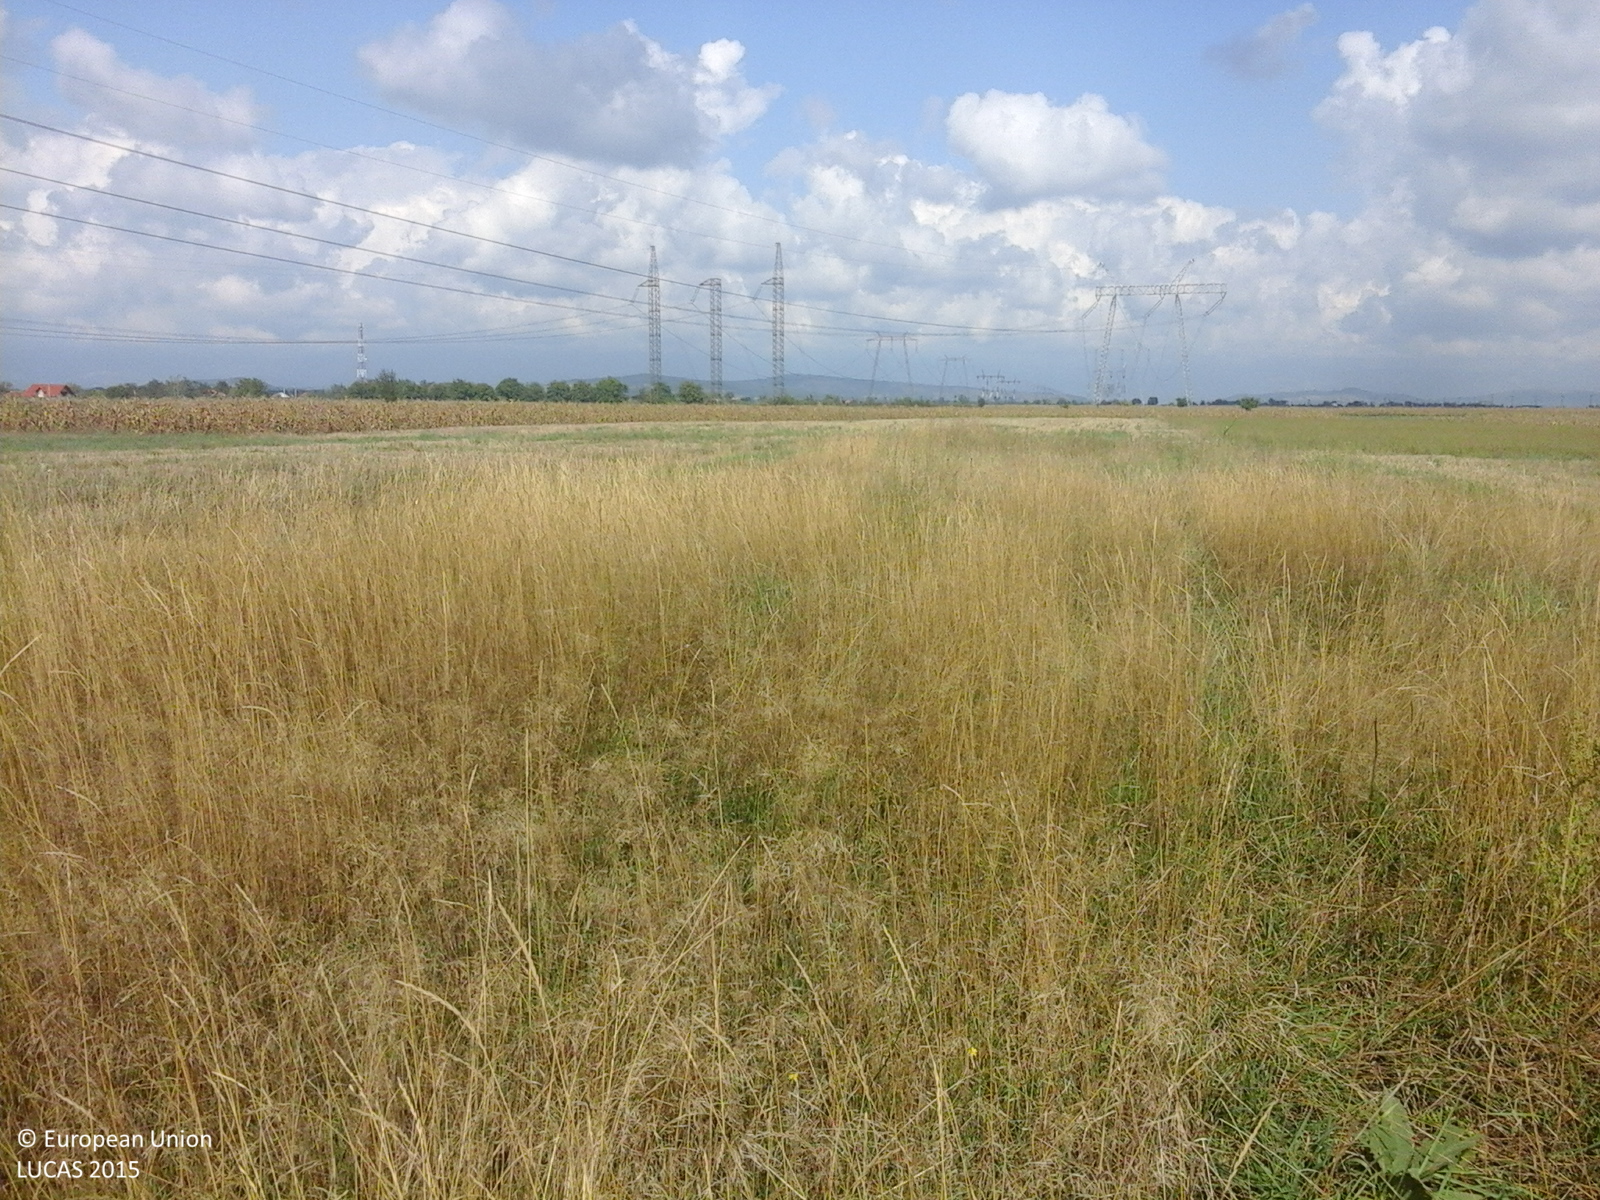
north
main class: Grassland
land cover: Spontaneously vegetated surfaces
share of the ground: > 75 %
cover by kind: herbaceous plants 100 %
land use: Fallow land
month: September
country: RO
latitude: 45.0278
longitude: 23.5499
